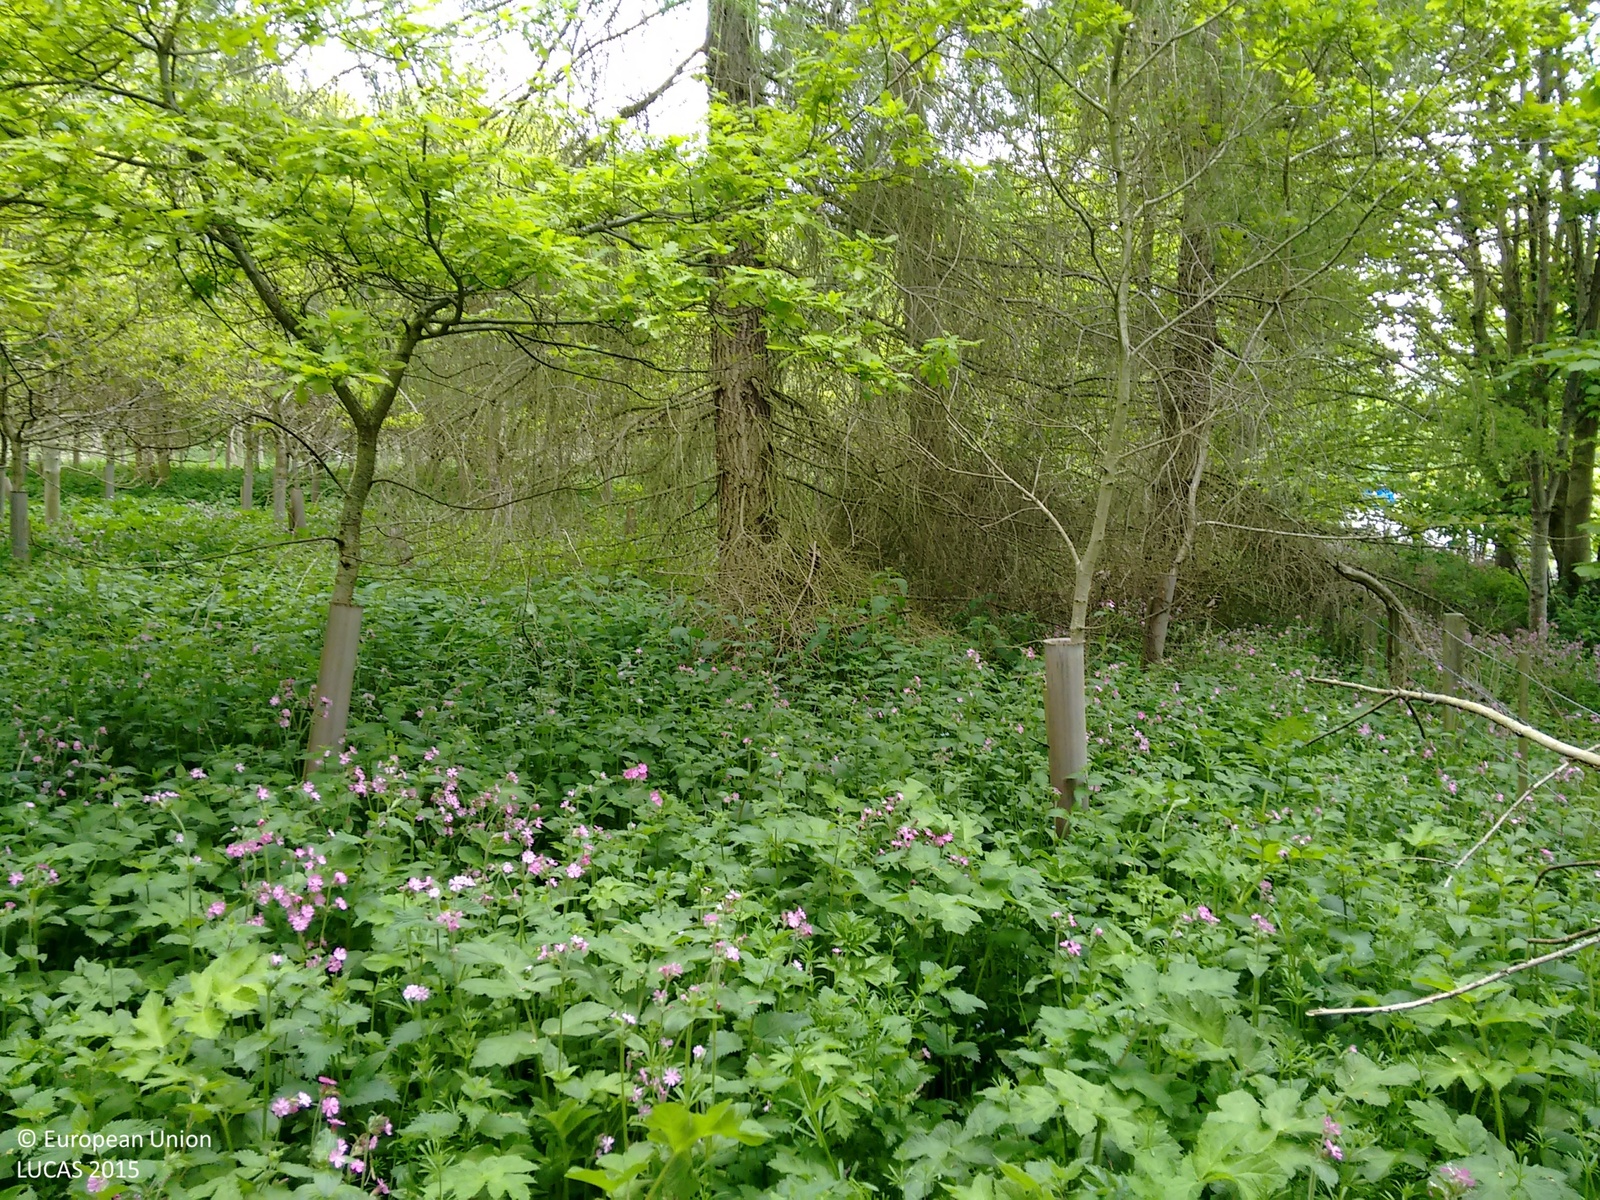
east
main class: Woodland
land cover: Broadleaved woodland
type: hemiboreal forest and nemoral coniferous forest and mixed broadleaved-coniferous forest
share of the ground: > 75 %
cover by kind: broadleaved forest trees 80 %, coniferous forest trees 10 %, shrubs 5 %, herbaceous plants 5 %
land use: Semi-natural and natural areas not in use
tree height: > 5 m
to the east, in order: Broadleaved woodland; Spruce dominated mixed woodland
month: May
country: GB
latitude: 55.8481
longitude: -2.1125
